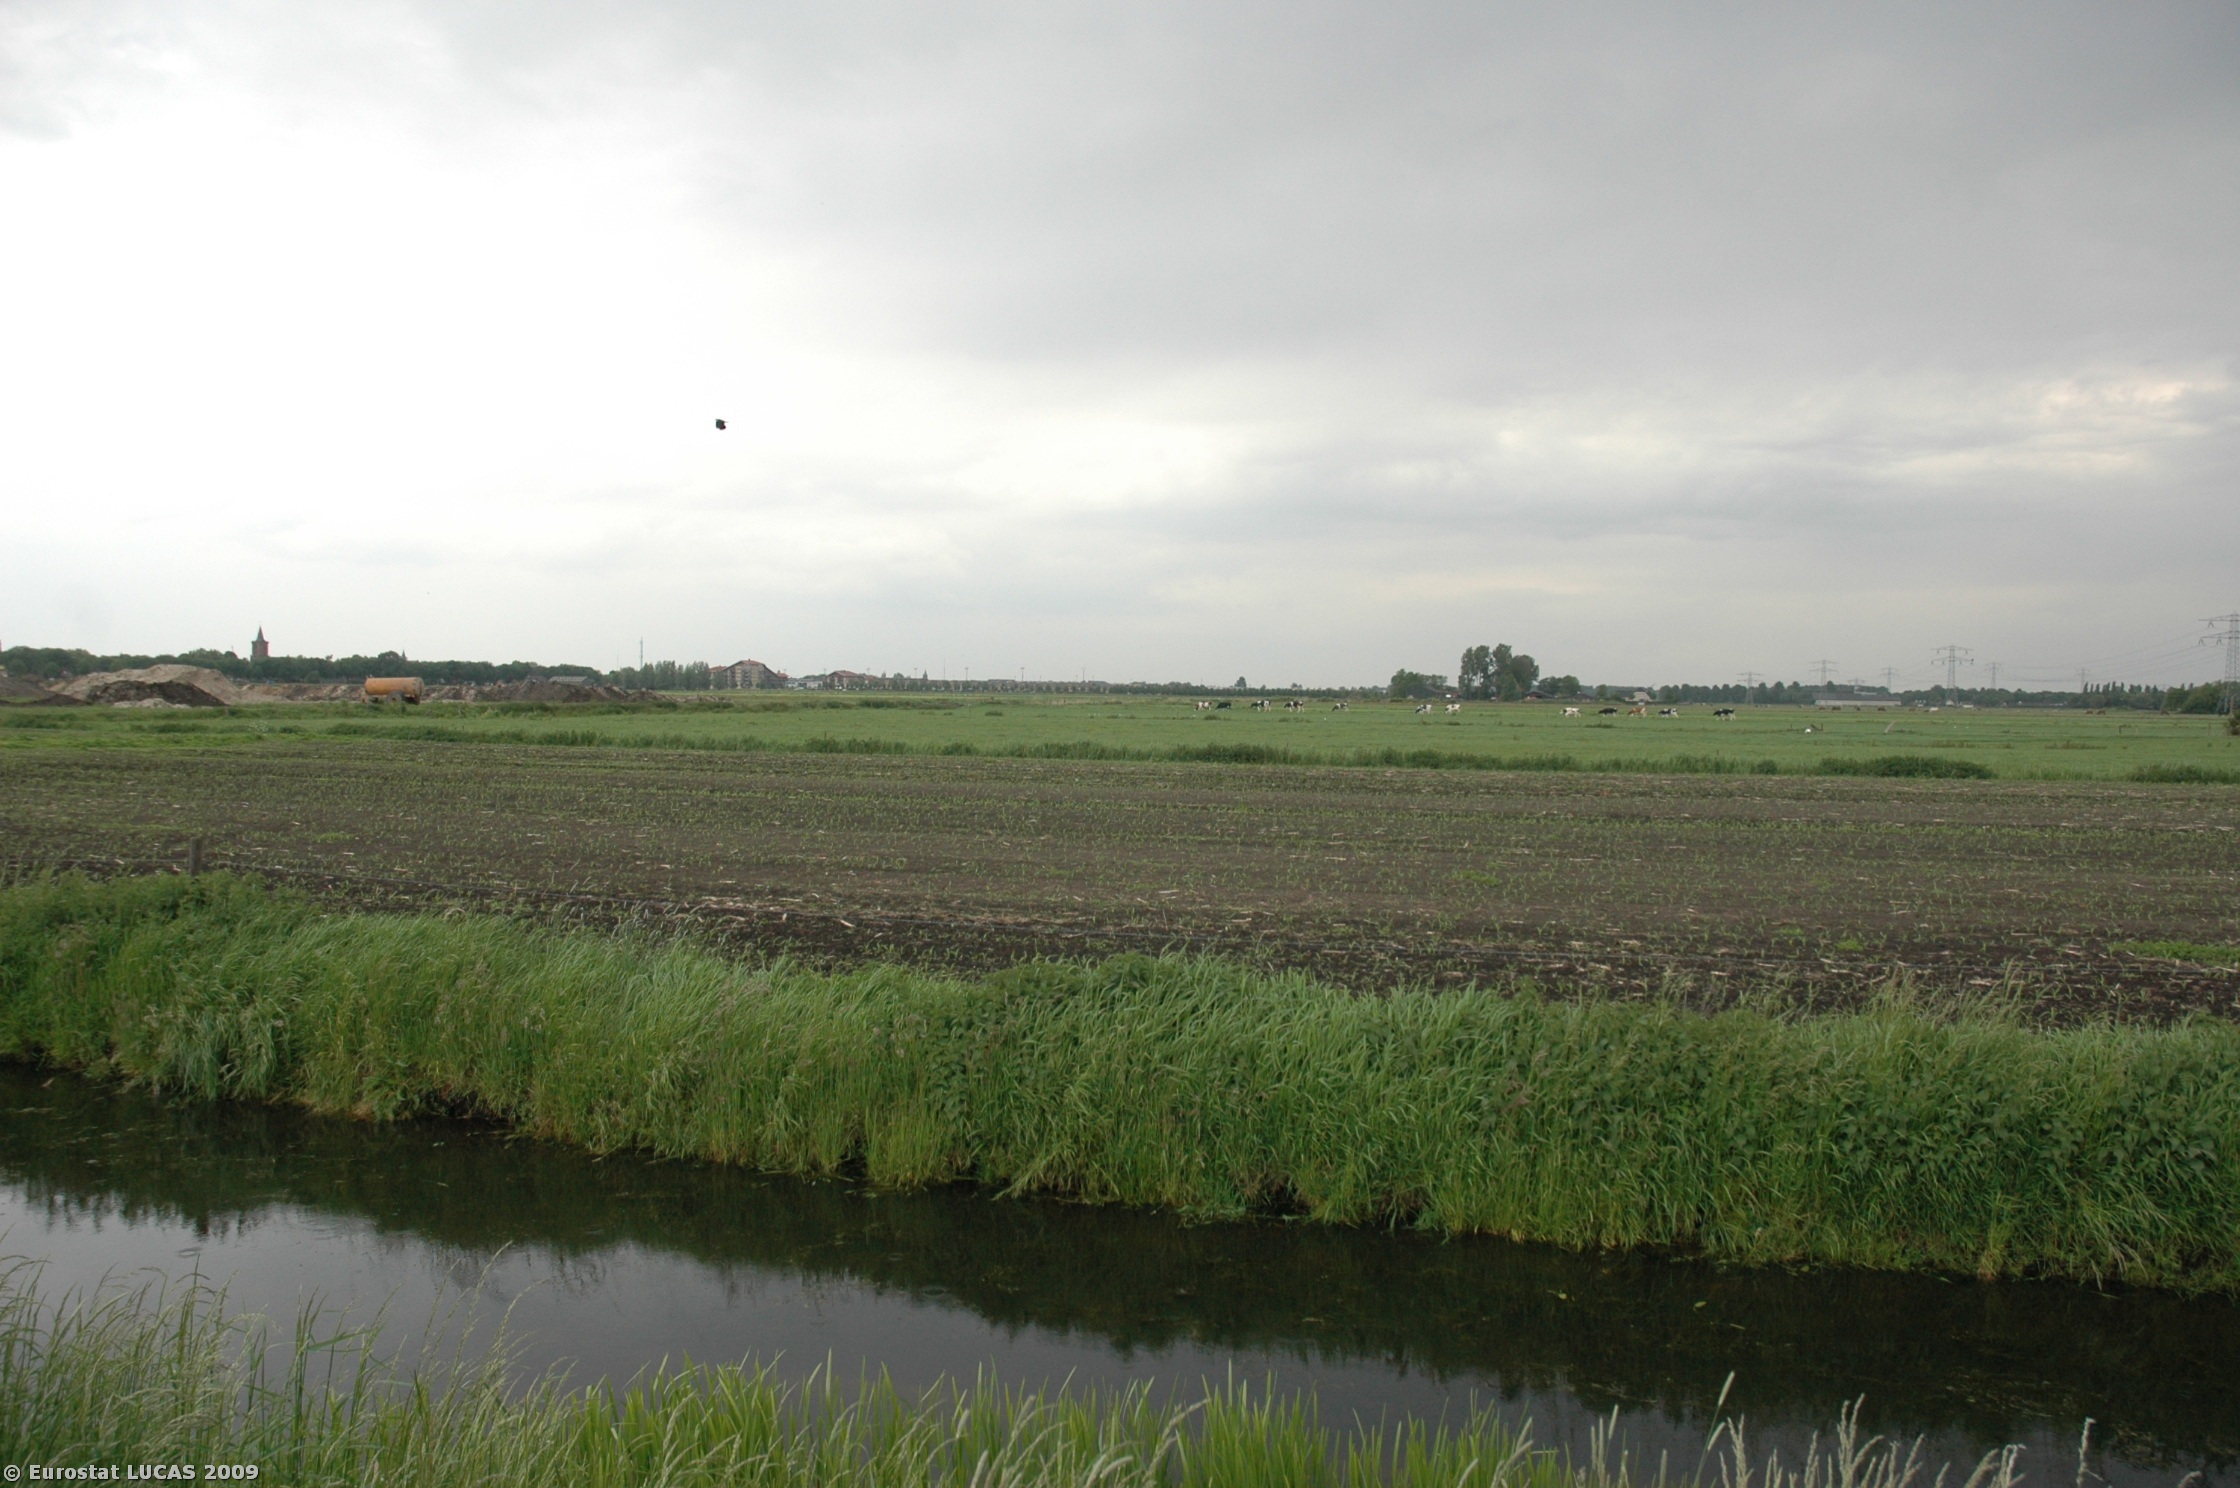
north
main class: Grassland
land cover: Grassland without tree/shrub cover
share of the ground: > 75 %
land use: Agriculture (excluding fallow land and kitchen gardens)
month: May
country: NL
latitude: 52.2338
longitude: 5.3858
